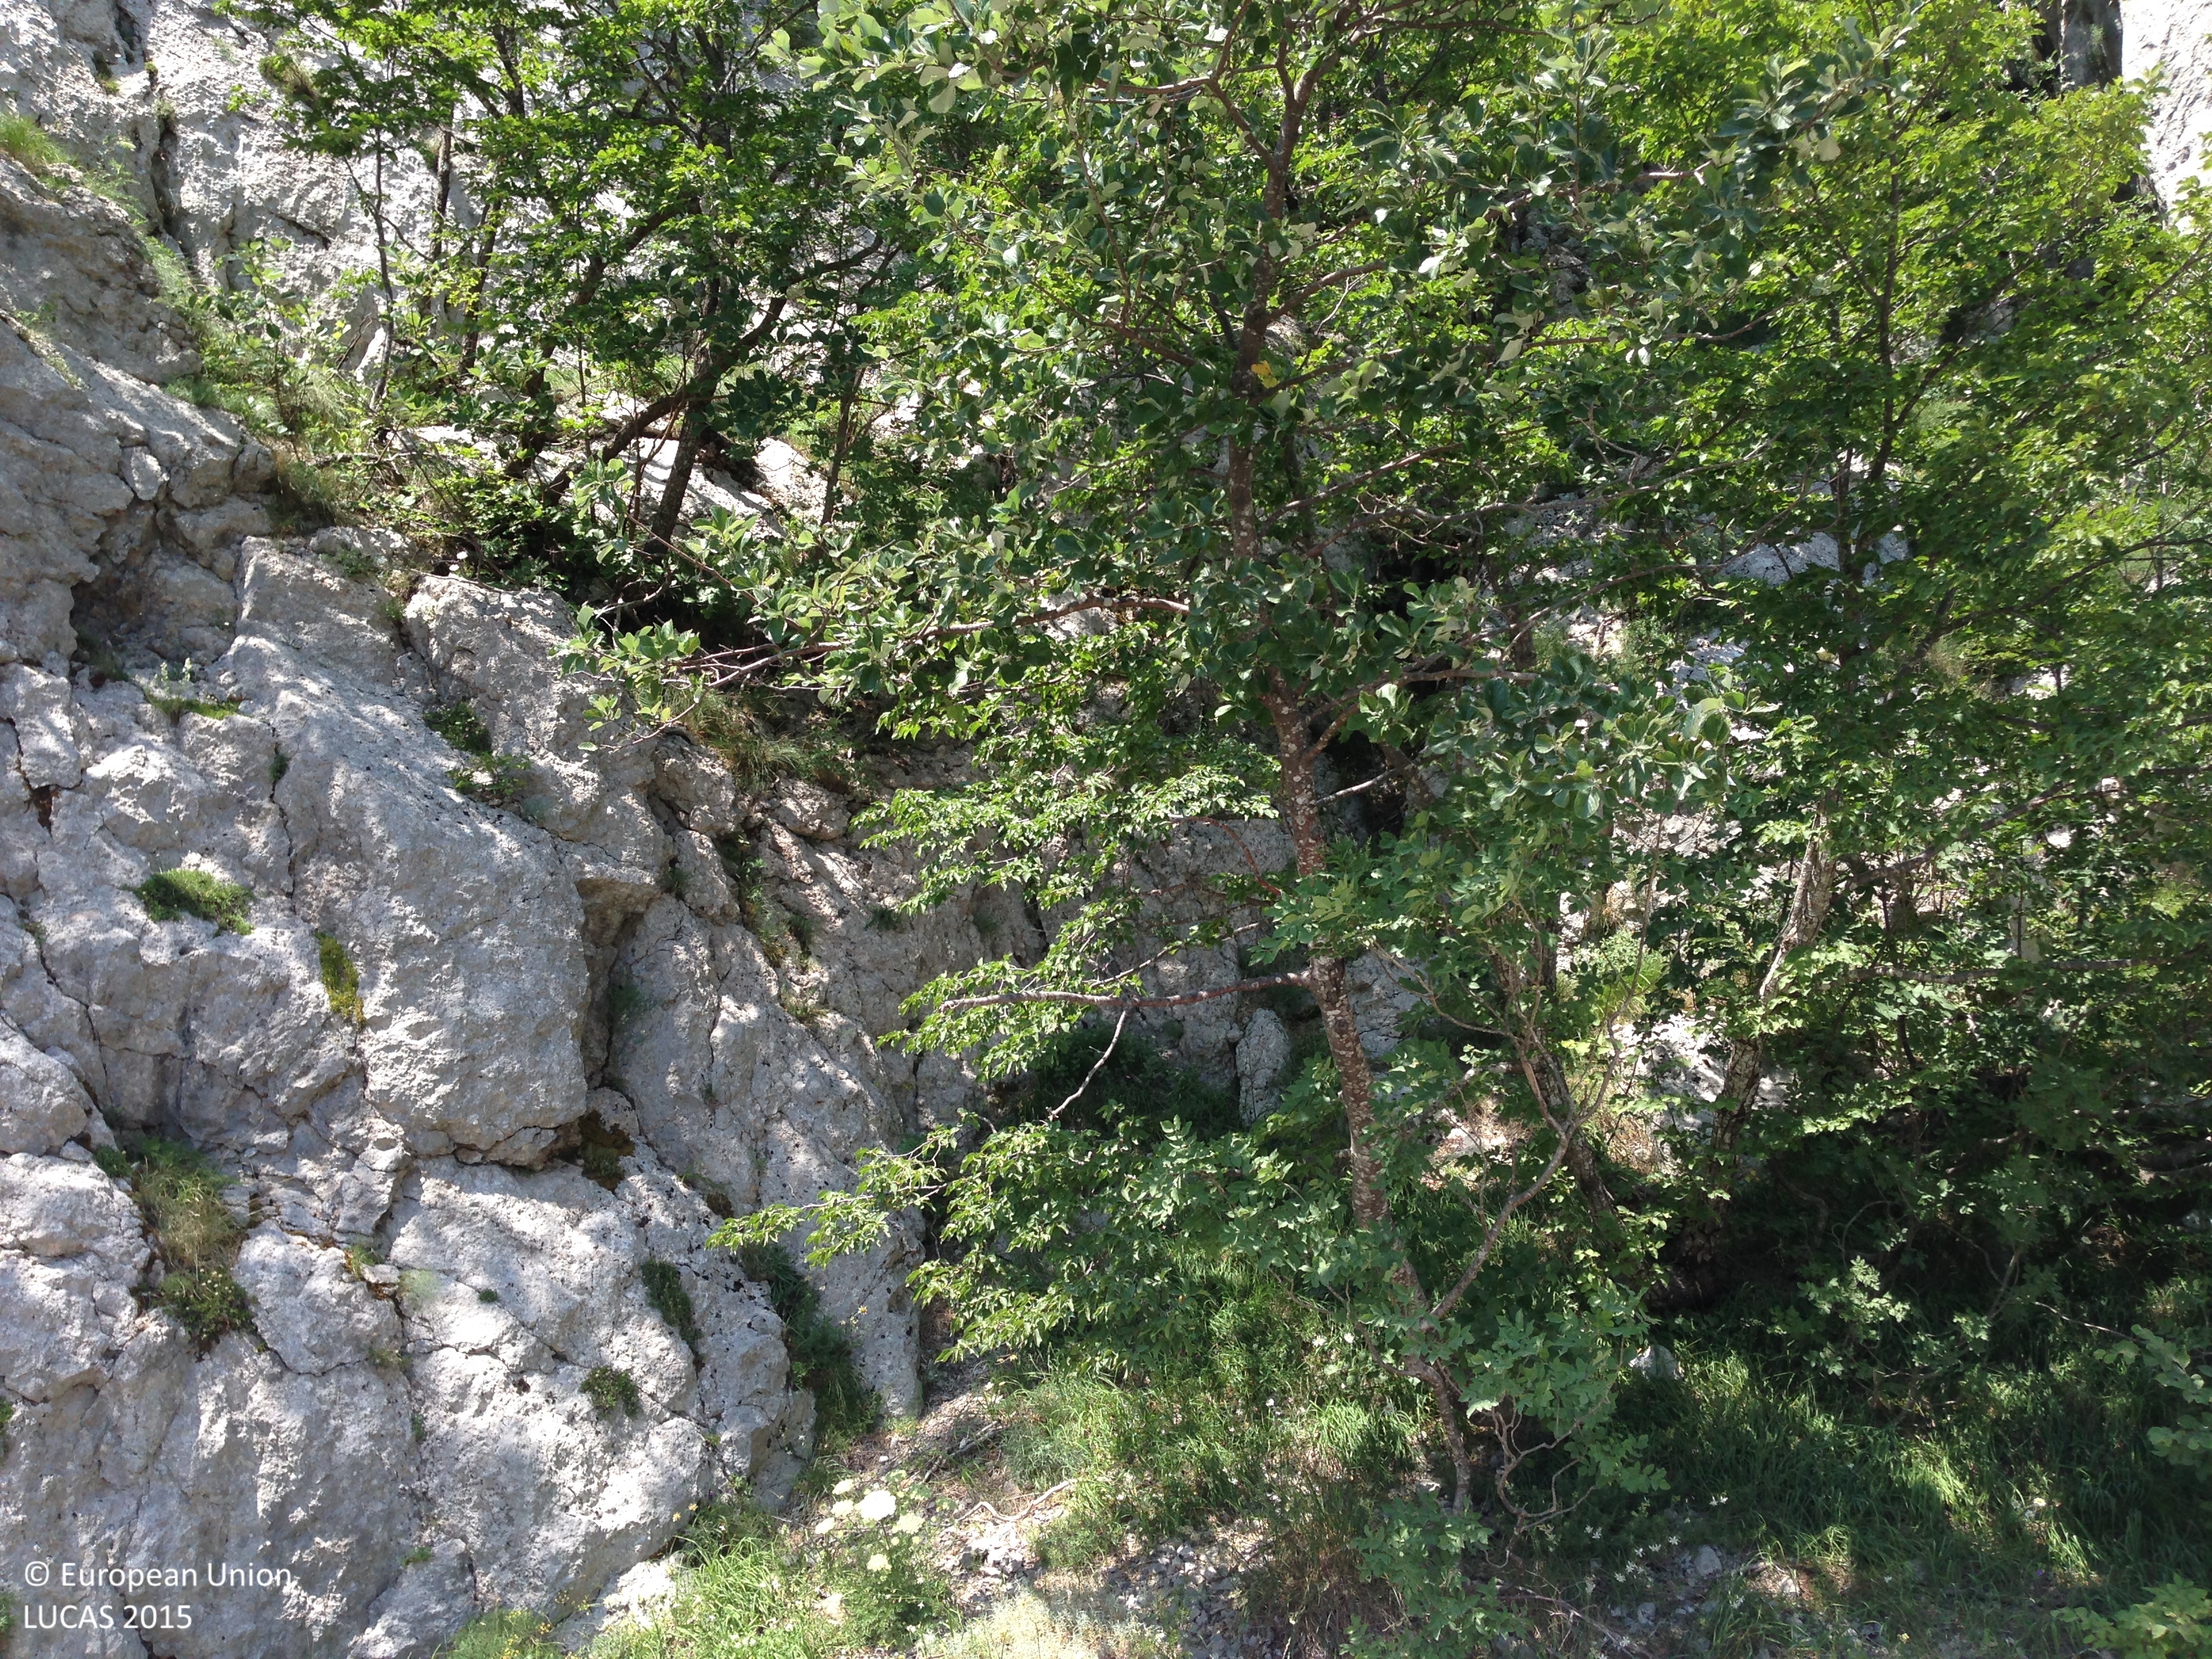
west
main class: Woodland
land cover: Broadleaved woodland
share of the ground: 10 - 25 %
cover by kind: consolidated bare surface 70 %, broadleaved forest trees 20 %, shrubs 10 %
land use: Semi-natural and natural areas not in use
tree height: > 5 m
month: July
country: HR
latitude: 44.5676
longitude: 15.1180
